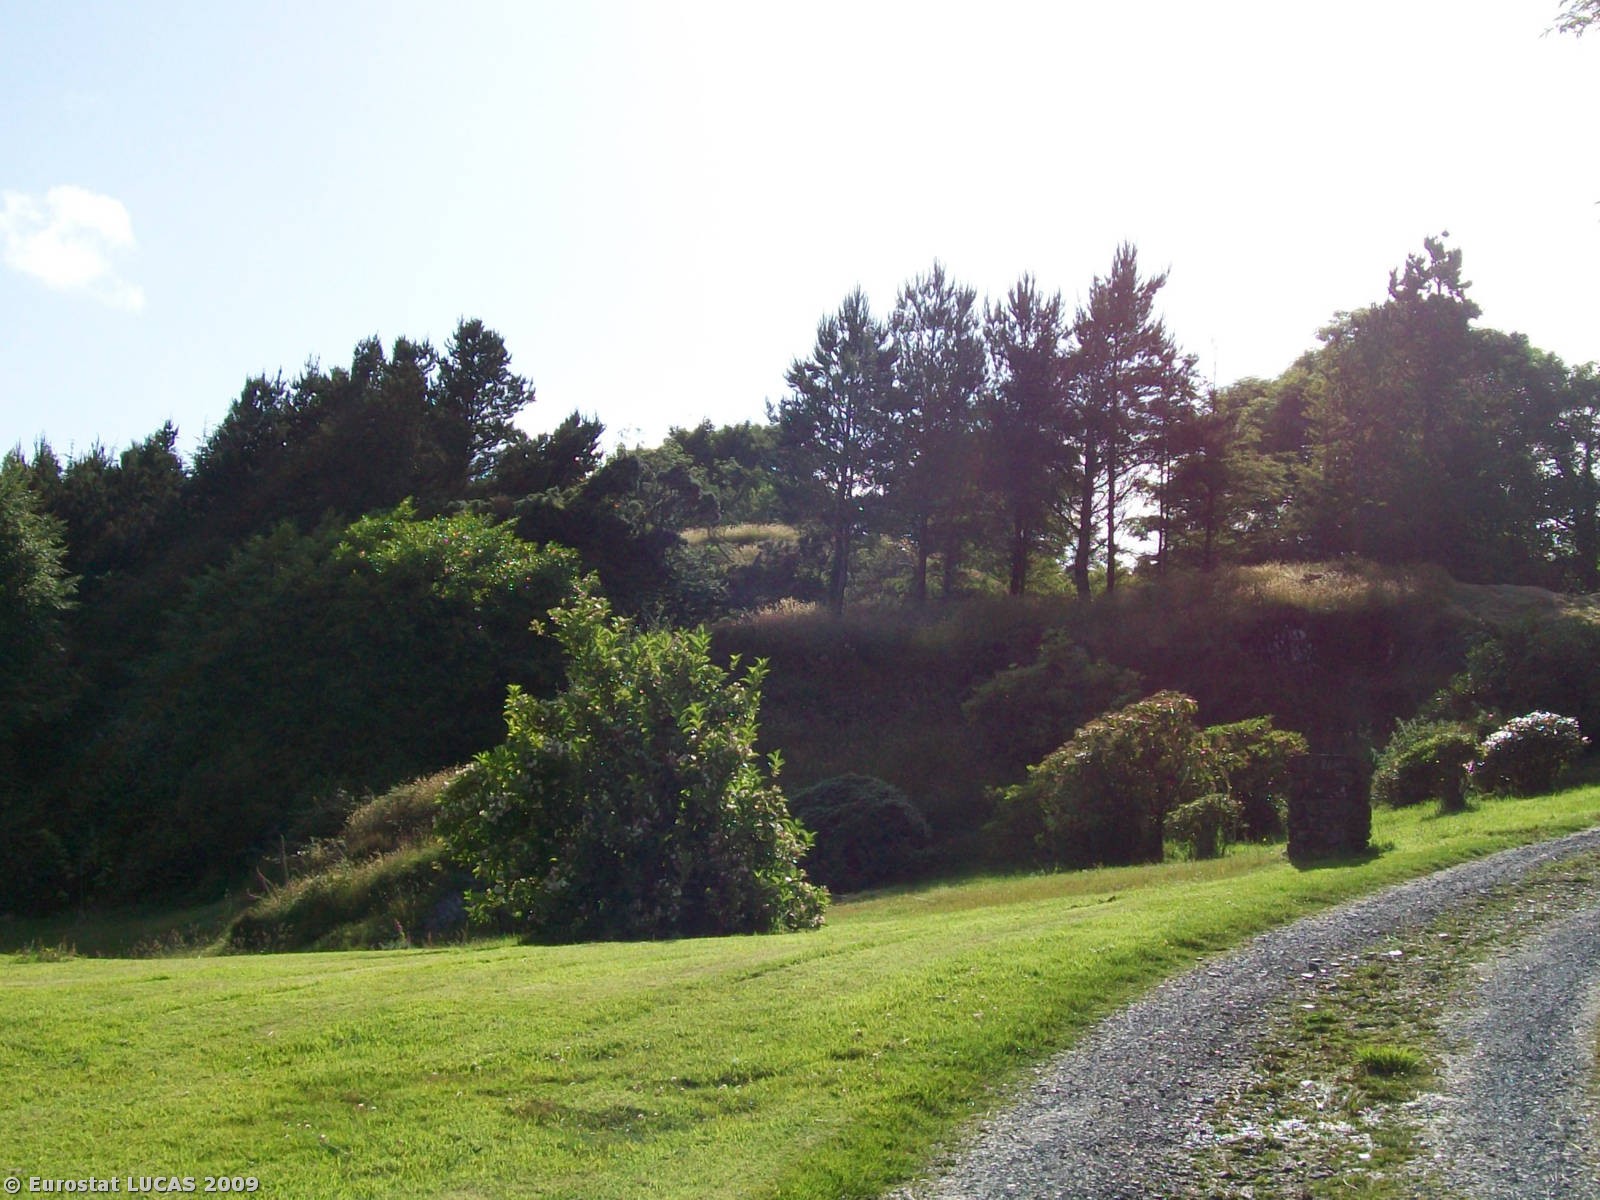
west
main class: Grassland
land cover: Grassland without tree/shrub cover
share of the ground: > 75 %
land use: Amenities, museums, leisure
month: June
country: IE
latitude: 51.5510
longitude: -9.3947
